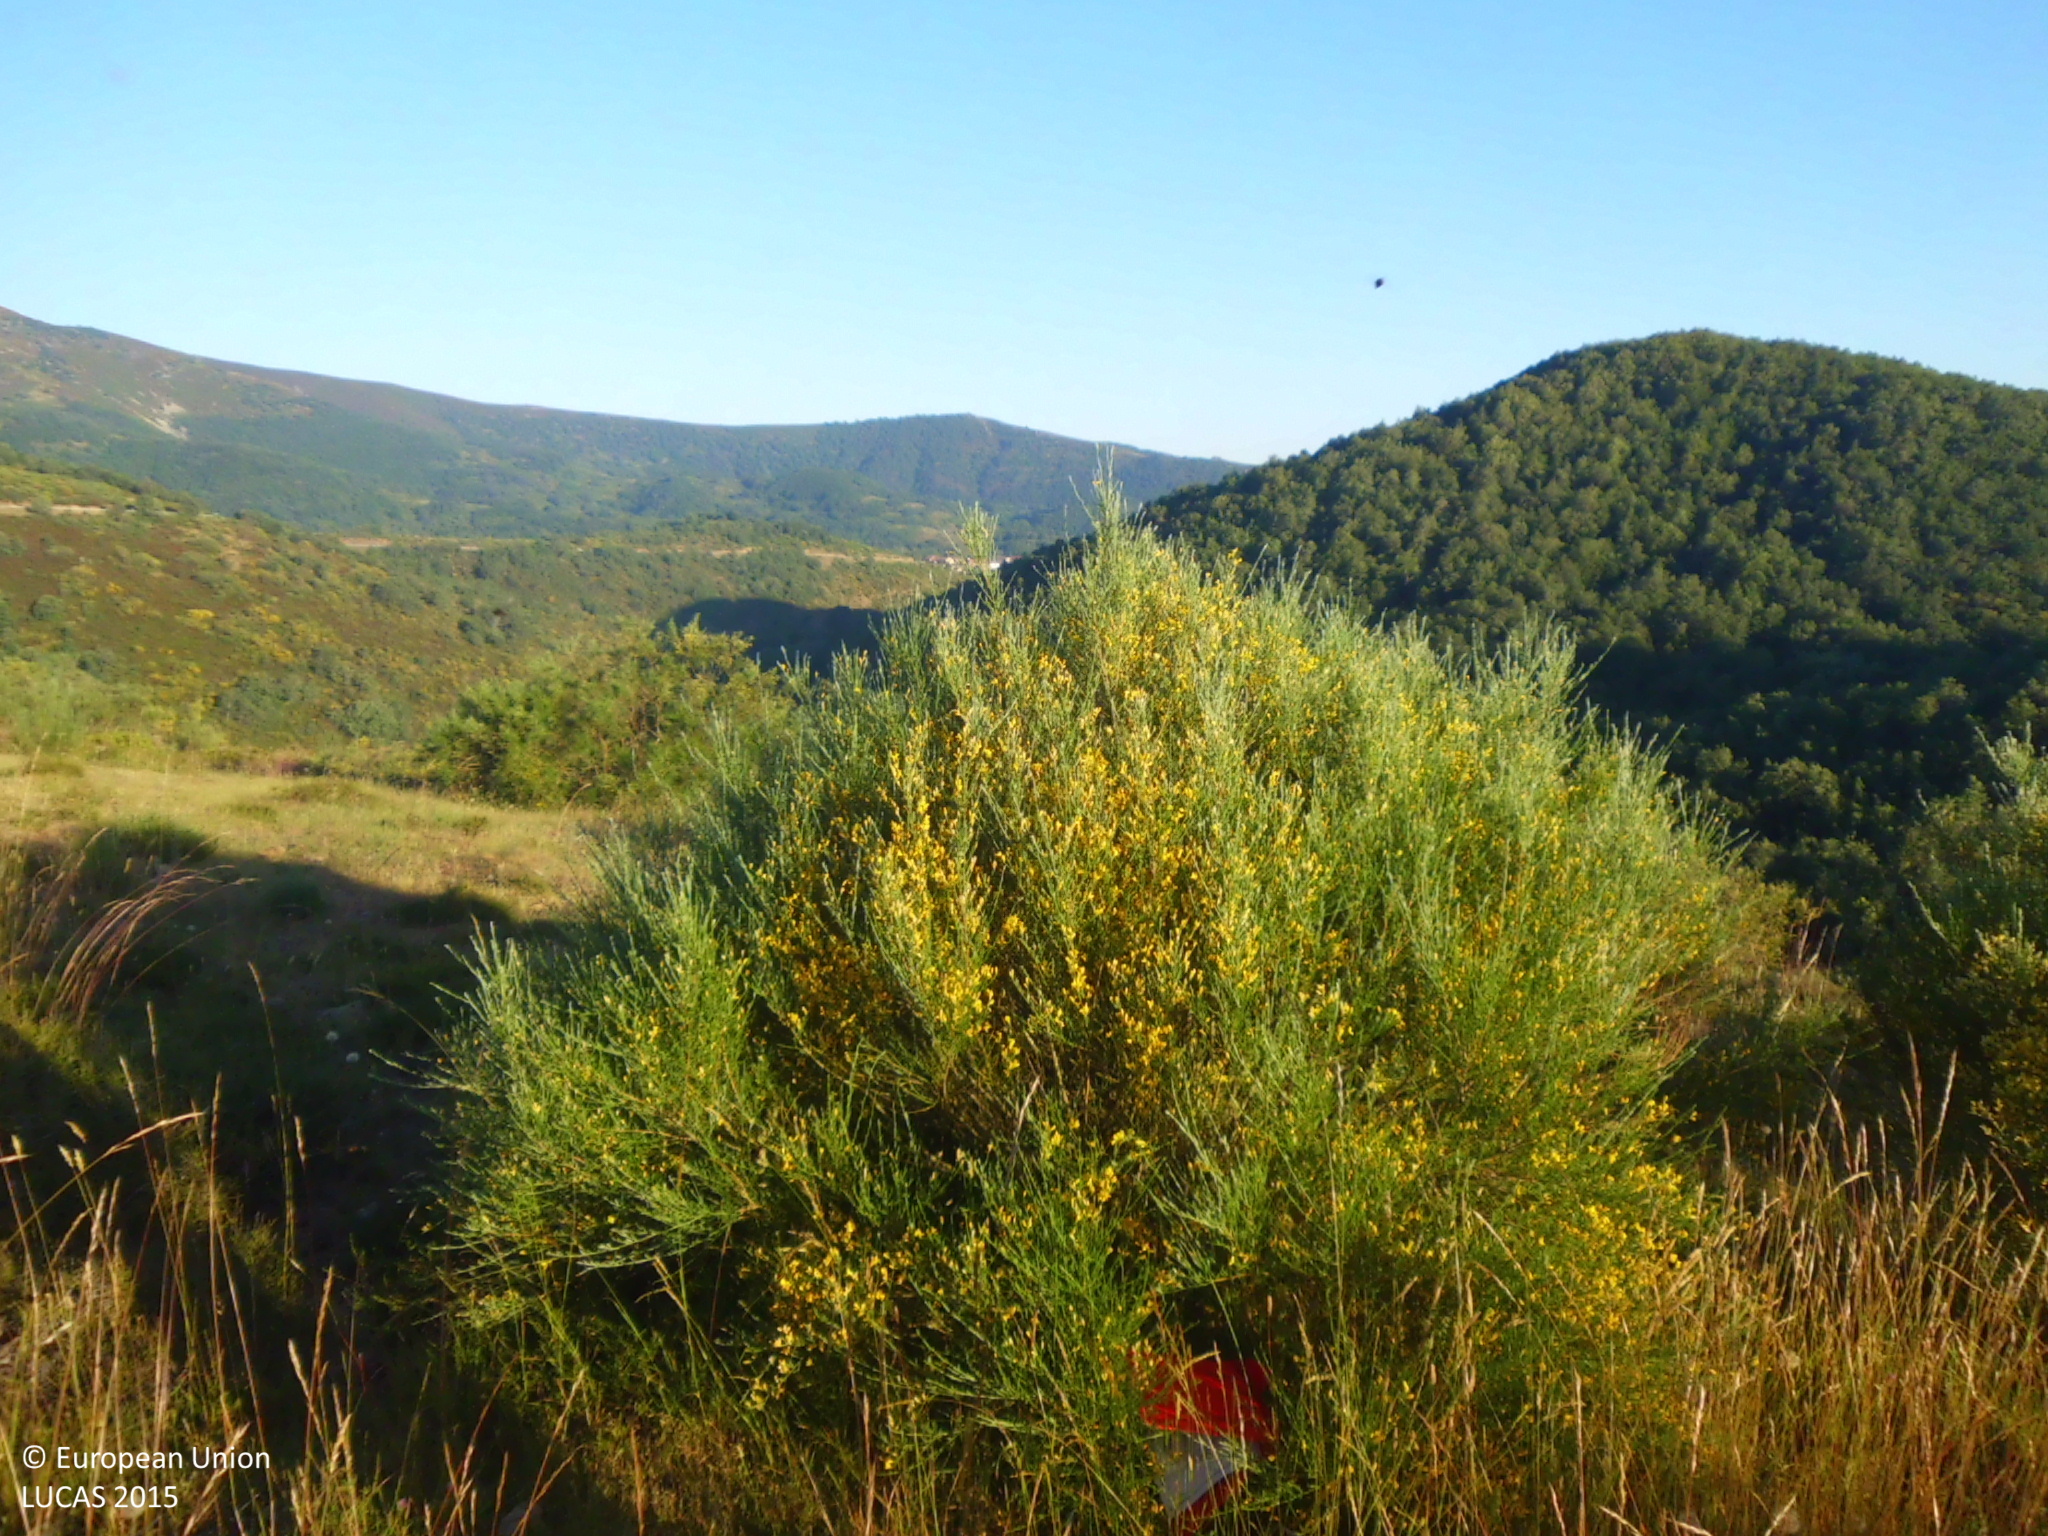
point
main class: Shrubland
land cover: Shrubland without tree cover
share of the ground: 25 - 50 %
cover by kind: shrubs 35 %, herbaceous plants 35 %, consolidated bare surface 30 %
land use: Agriculture (excluding fallow land and kitchen gardens)
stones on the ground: 10 - 25 %
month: June
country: ES
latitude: 42.9090
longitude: -4.9709
